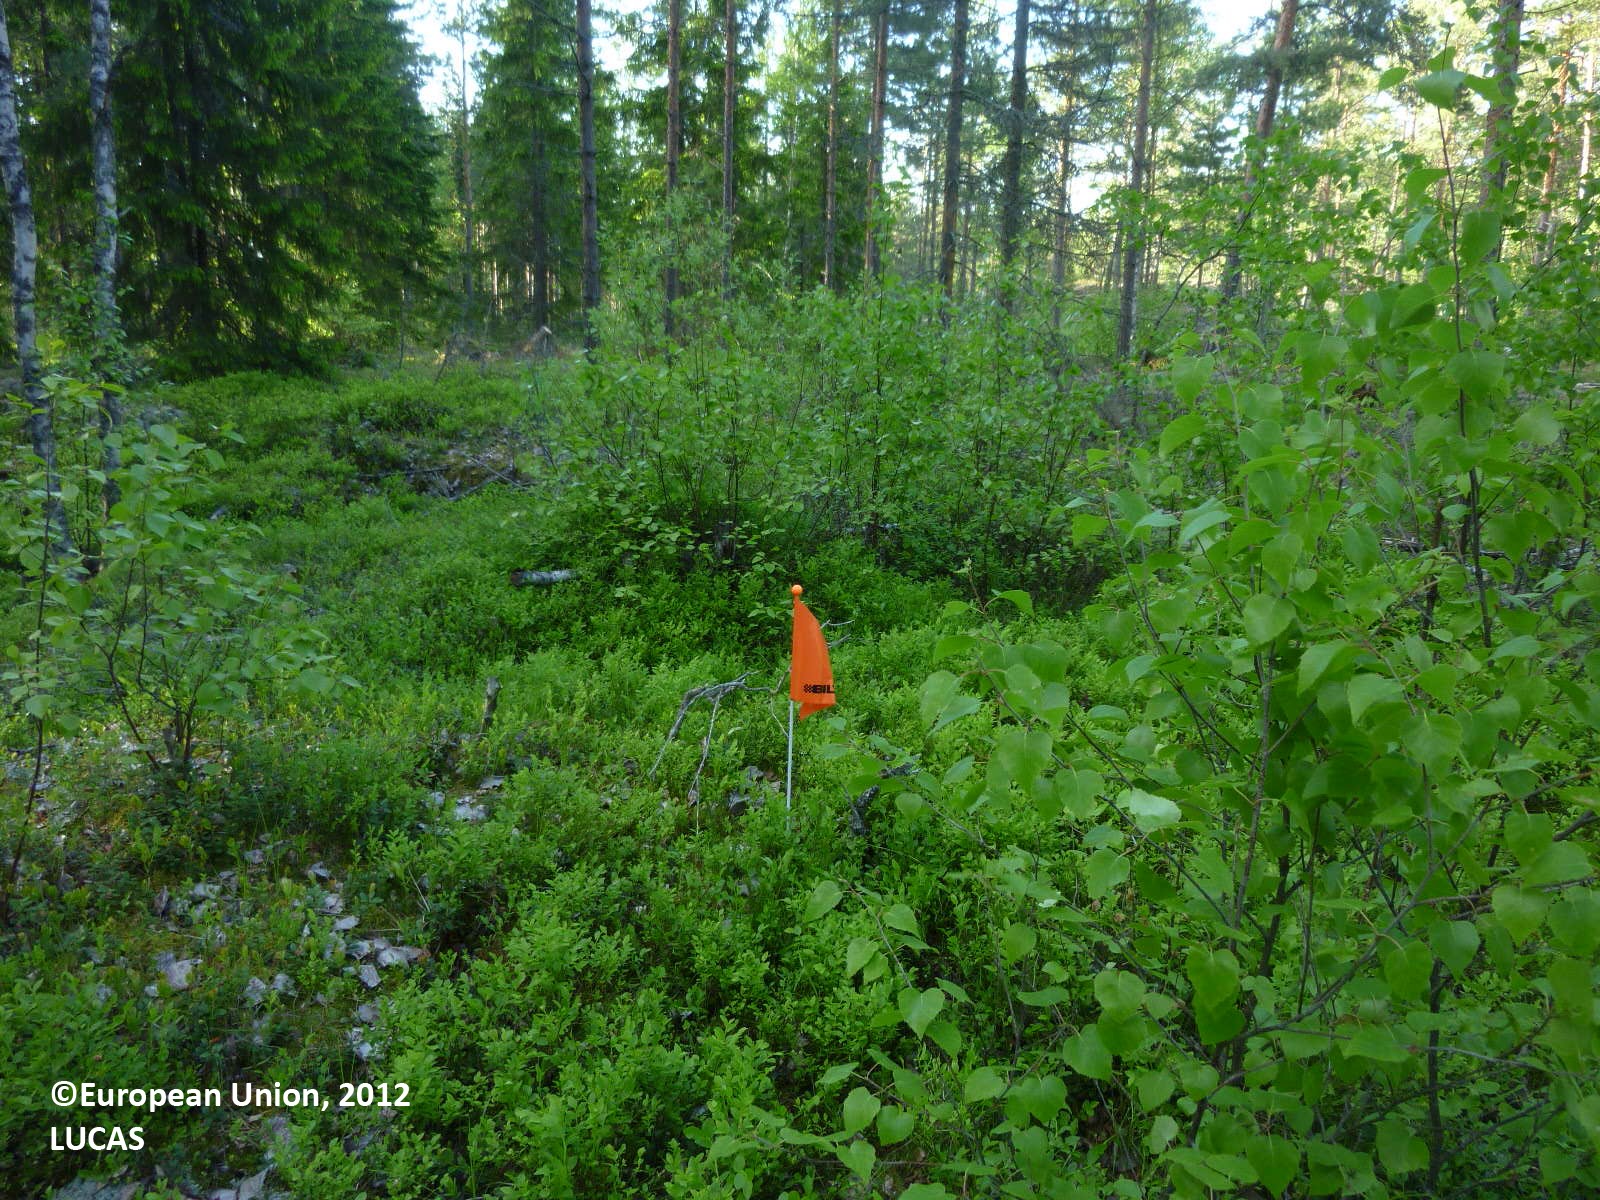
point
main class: Woodland
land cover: Pine dominated mixed woodland
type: boreal forest
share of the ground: 25 - 50 %
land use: Forestry
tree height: > 5 m
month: June
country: FI
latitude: 60.3441
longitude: 22.5926
